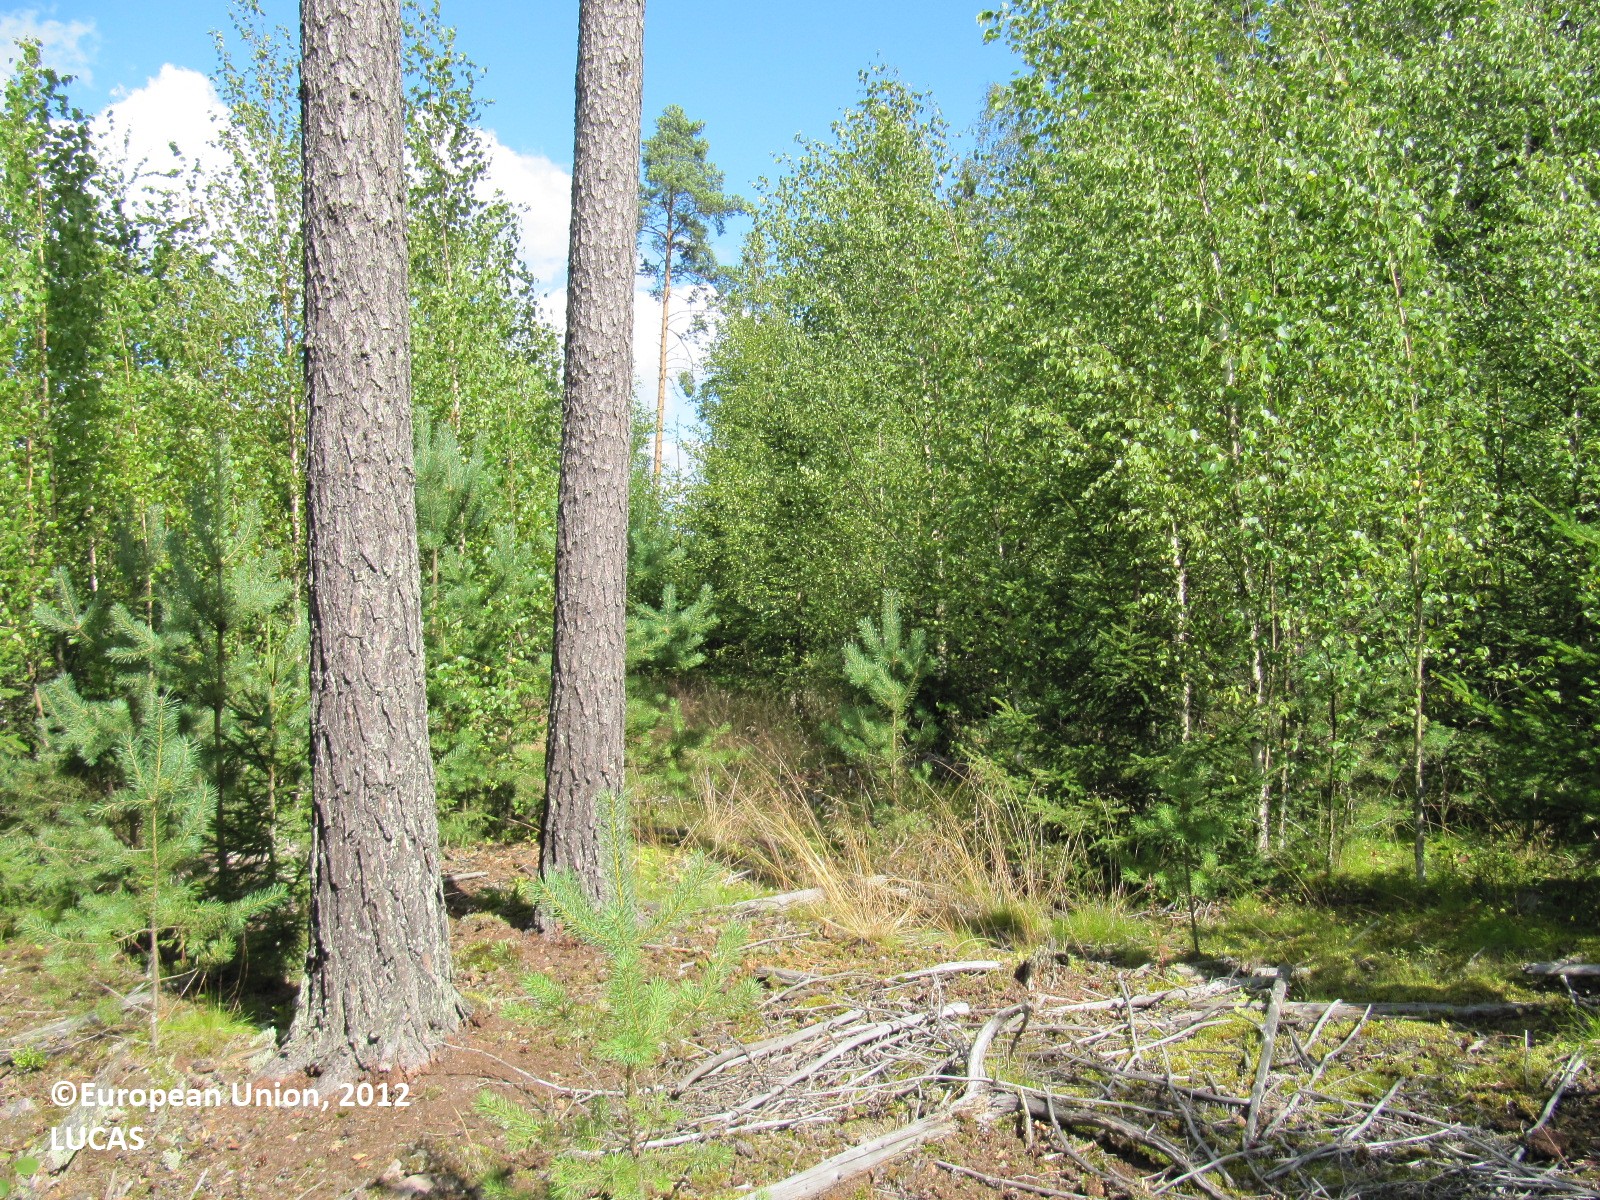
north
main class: Woodland
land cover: Other mixed woodland
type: boreal forest
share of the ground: 50 - 75 %
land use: Forestry
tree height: < 5 m
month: August
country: FI
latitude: 60.6018
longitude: 23.1747
